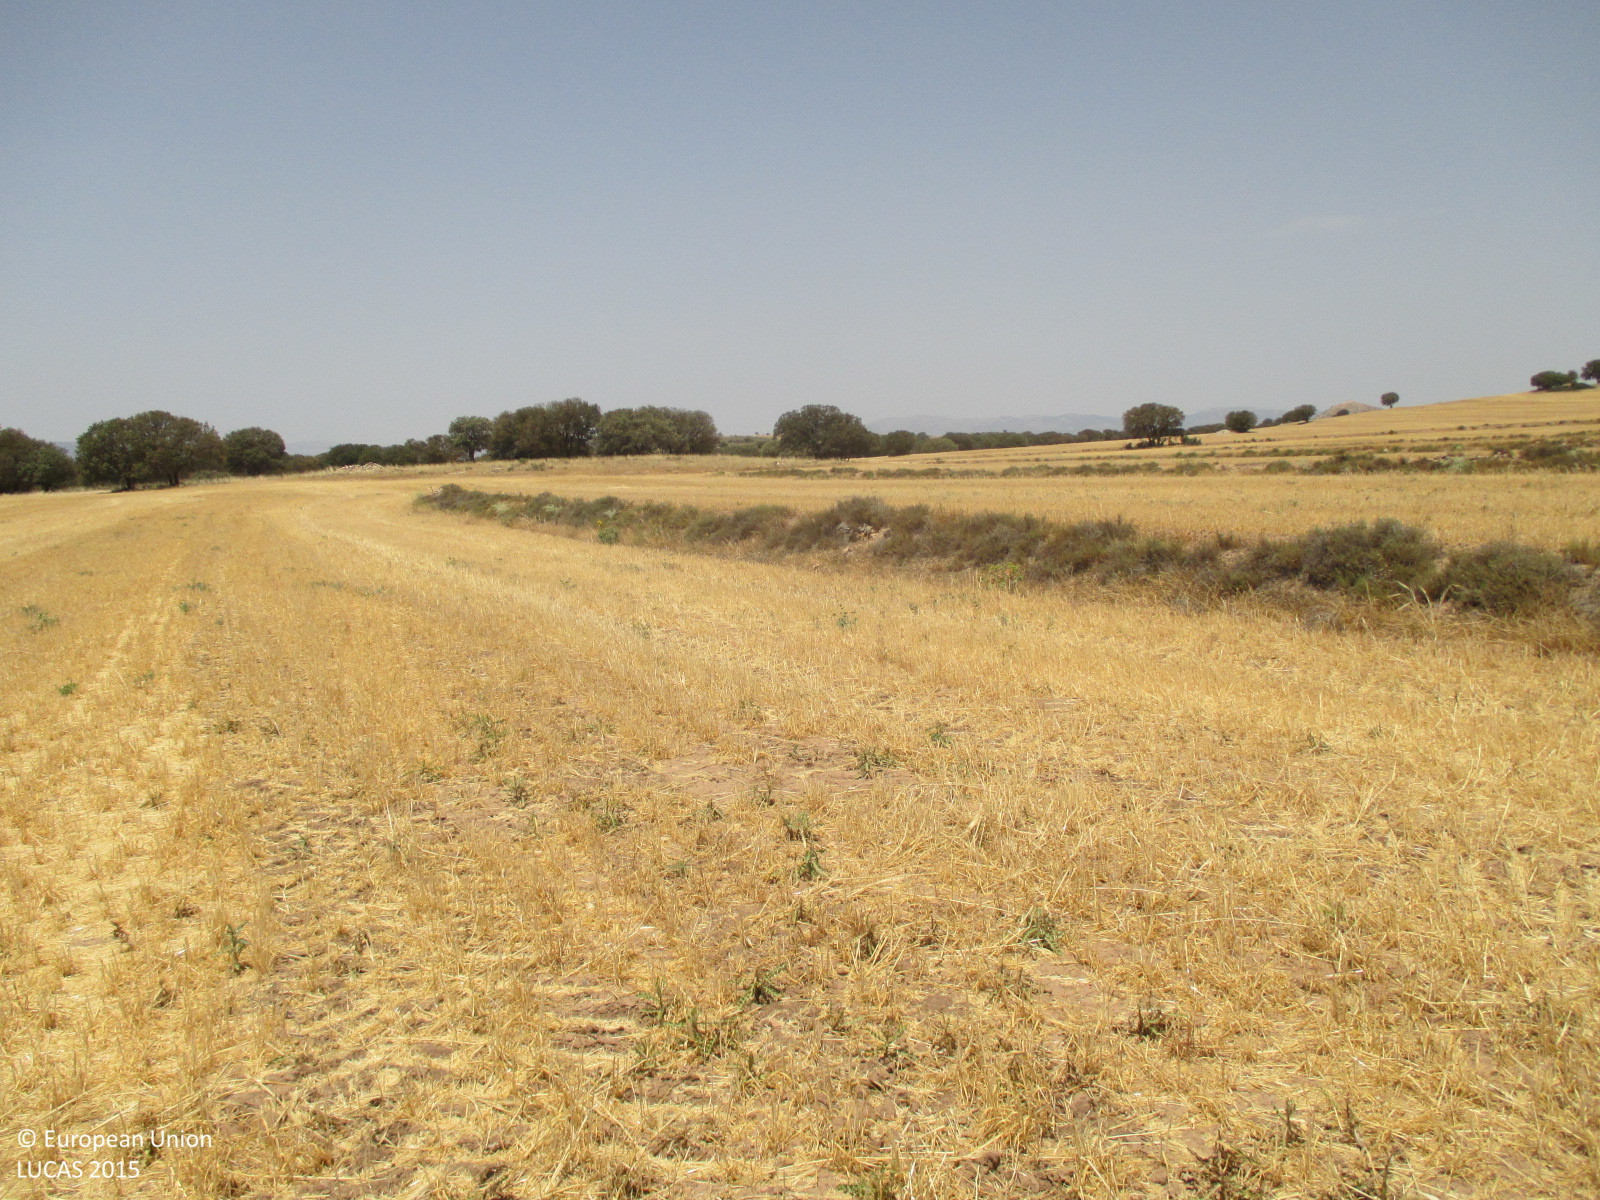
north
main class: Cropland
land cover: Barley
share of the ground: < 10 %
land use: Agriculture (excluding fallow land and kitchen gardens)
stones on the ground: < 10 %
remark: Harvested field
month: July
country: ES
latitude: 37.8469
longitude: -2.2734
